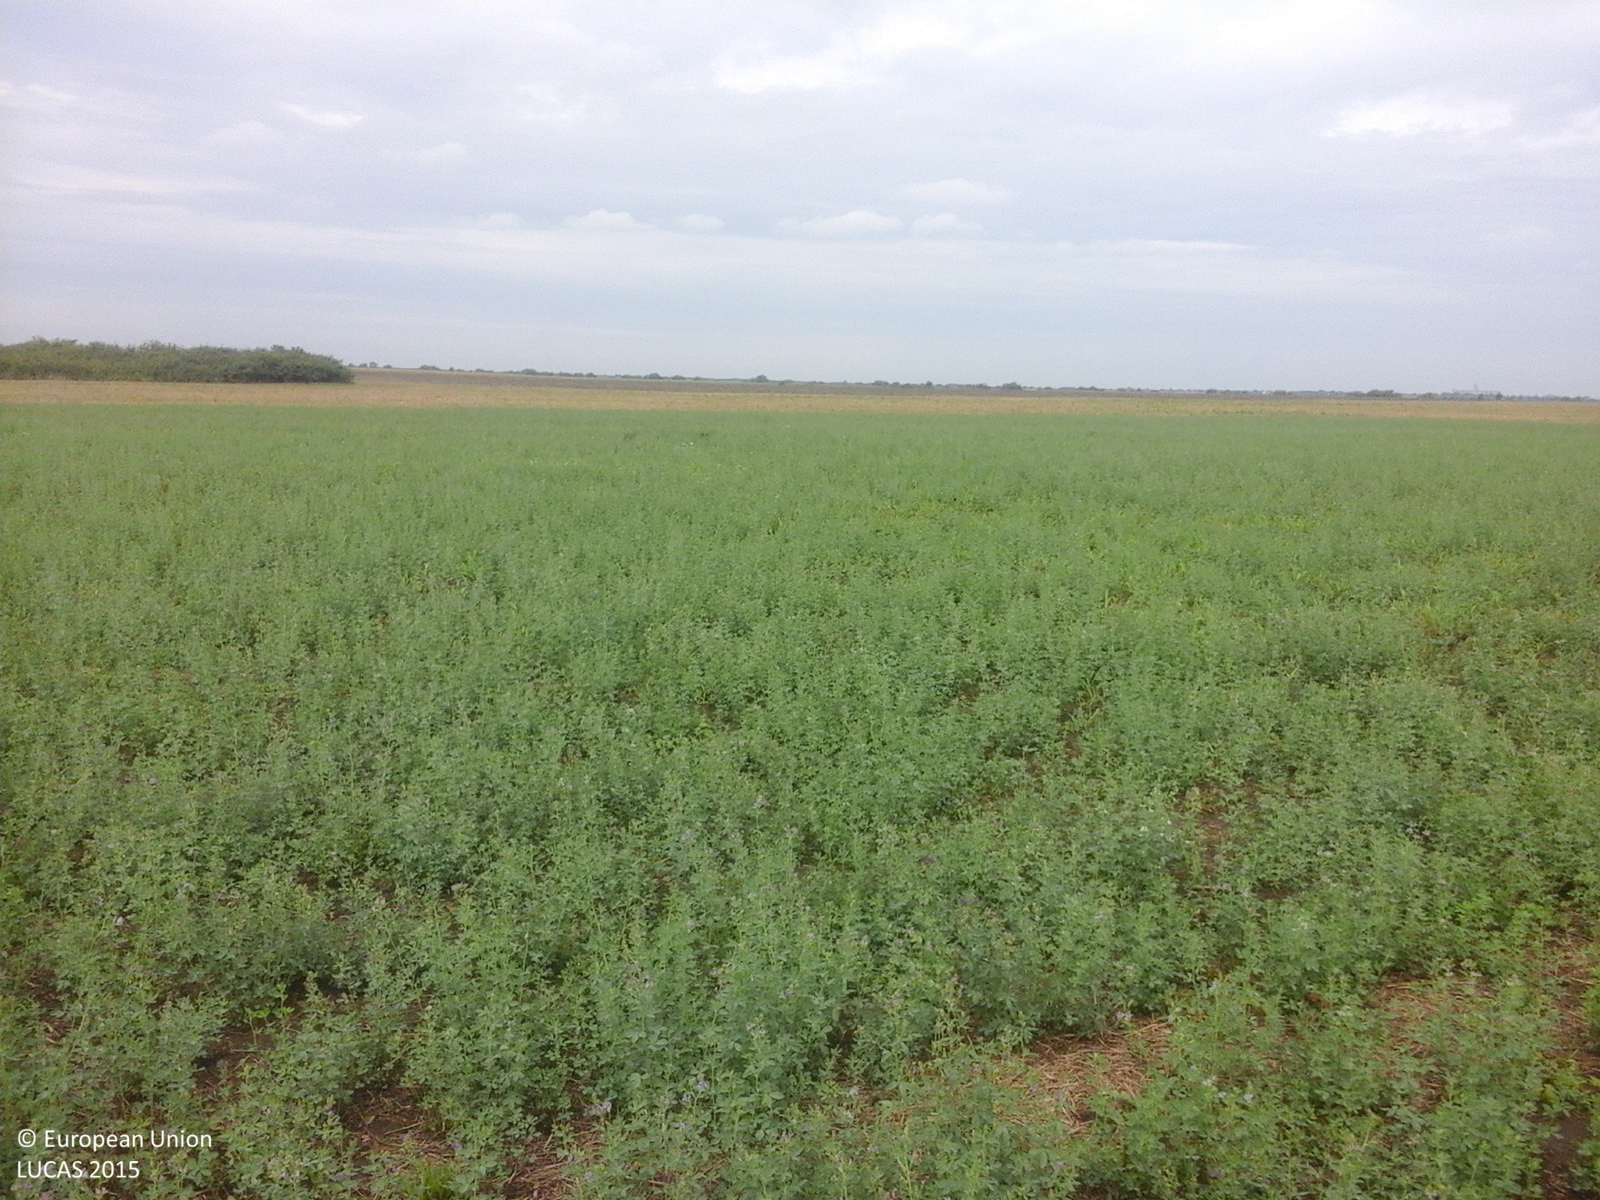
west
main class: Cropland
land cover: Lucerne
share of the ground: > 75 %
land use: Agriculture (excluding fallow land and kitchen gardens)
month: August
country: RO
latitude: 45.5364
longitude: 21.2605
